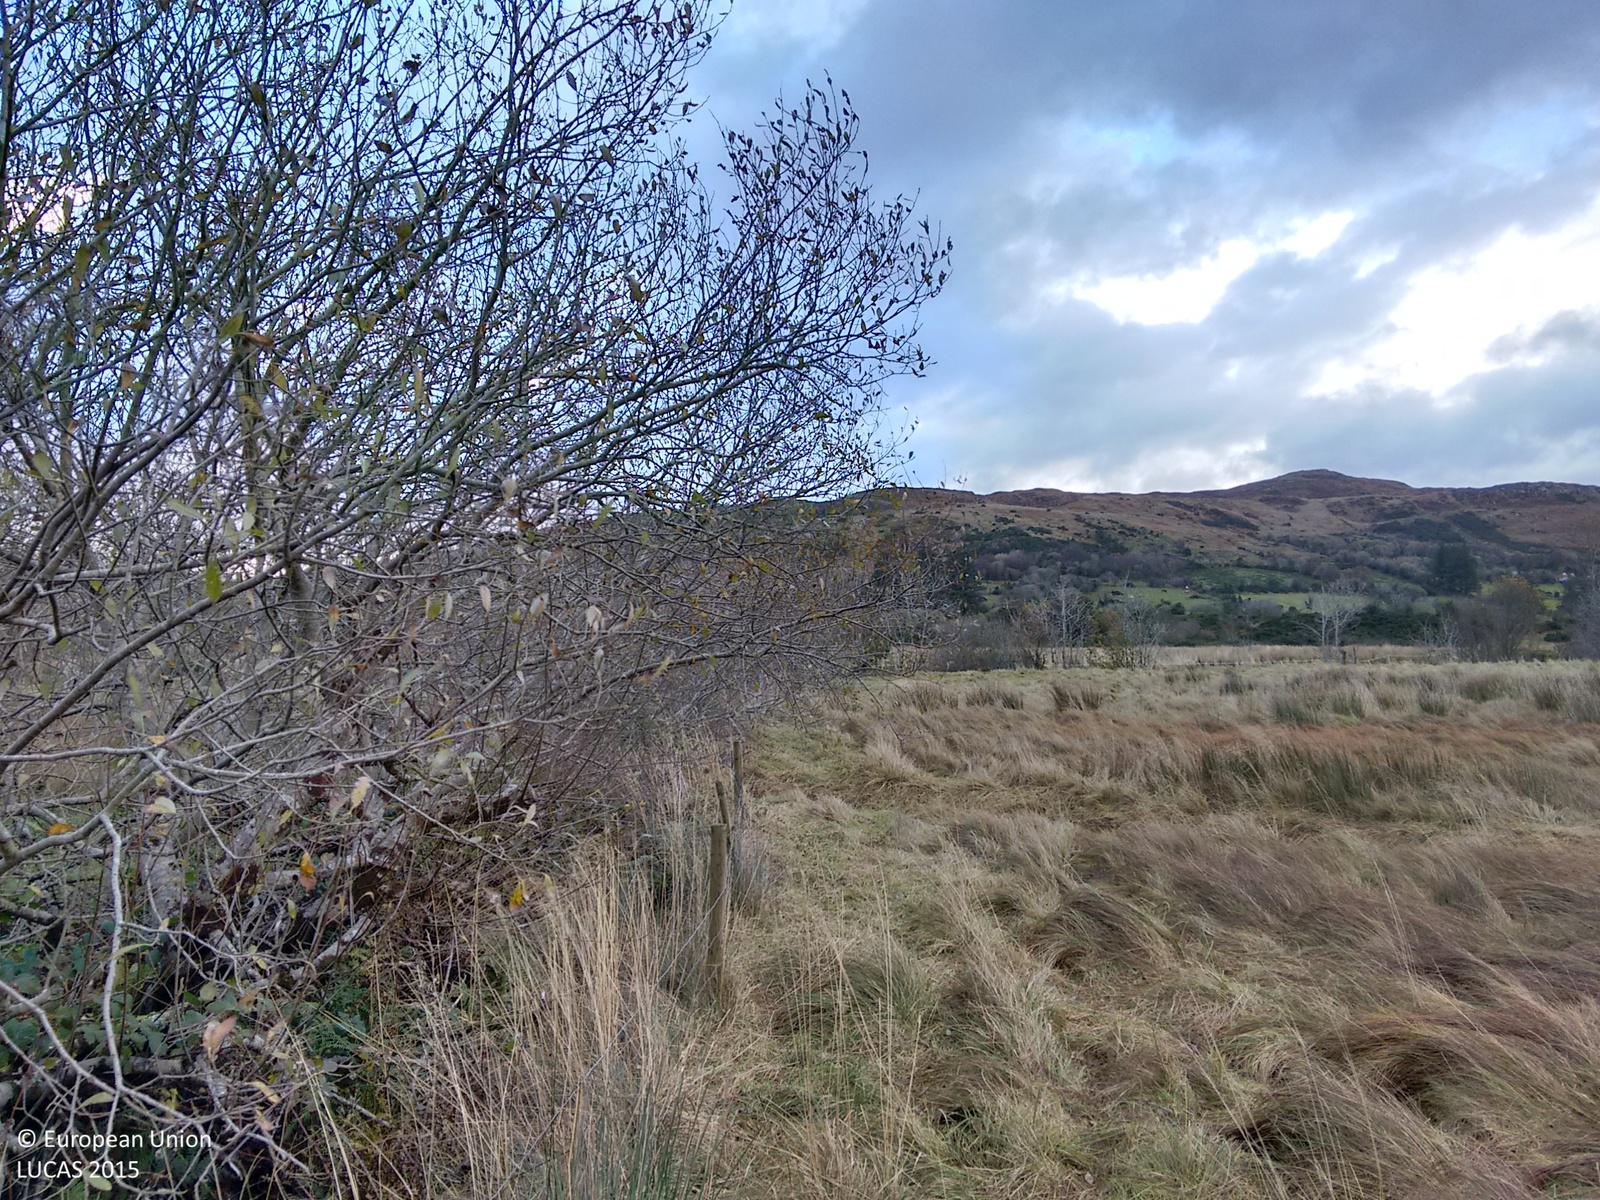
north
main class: Shrubland
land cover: Shrubland without tree cover
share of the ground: > 75 %
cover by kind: shrubs 70 %, herbaceous plants 30 %
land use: Agriculture (excluding fallow land and kitchen gardens)
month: November
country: IE
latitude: 54.7848
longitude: -8.2660
